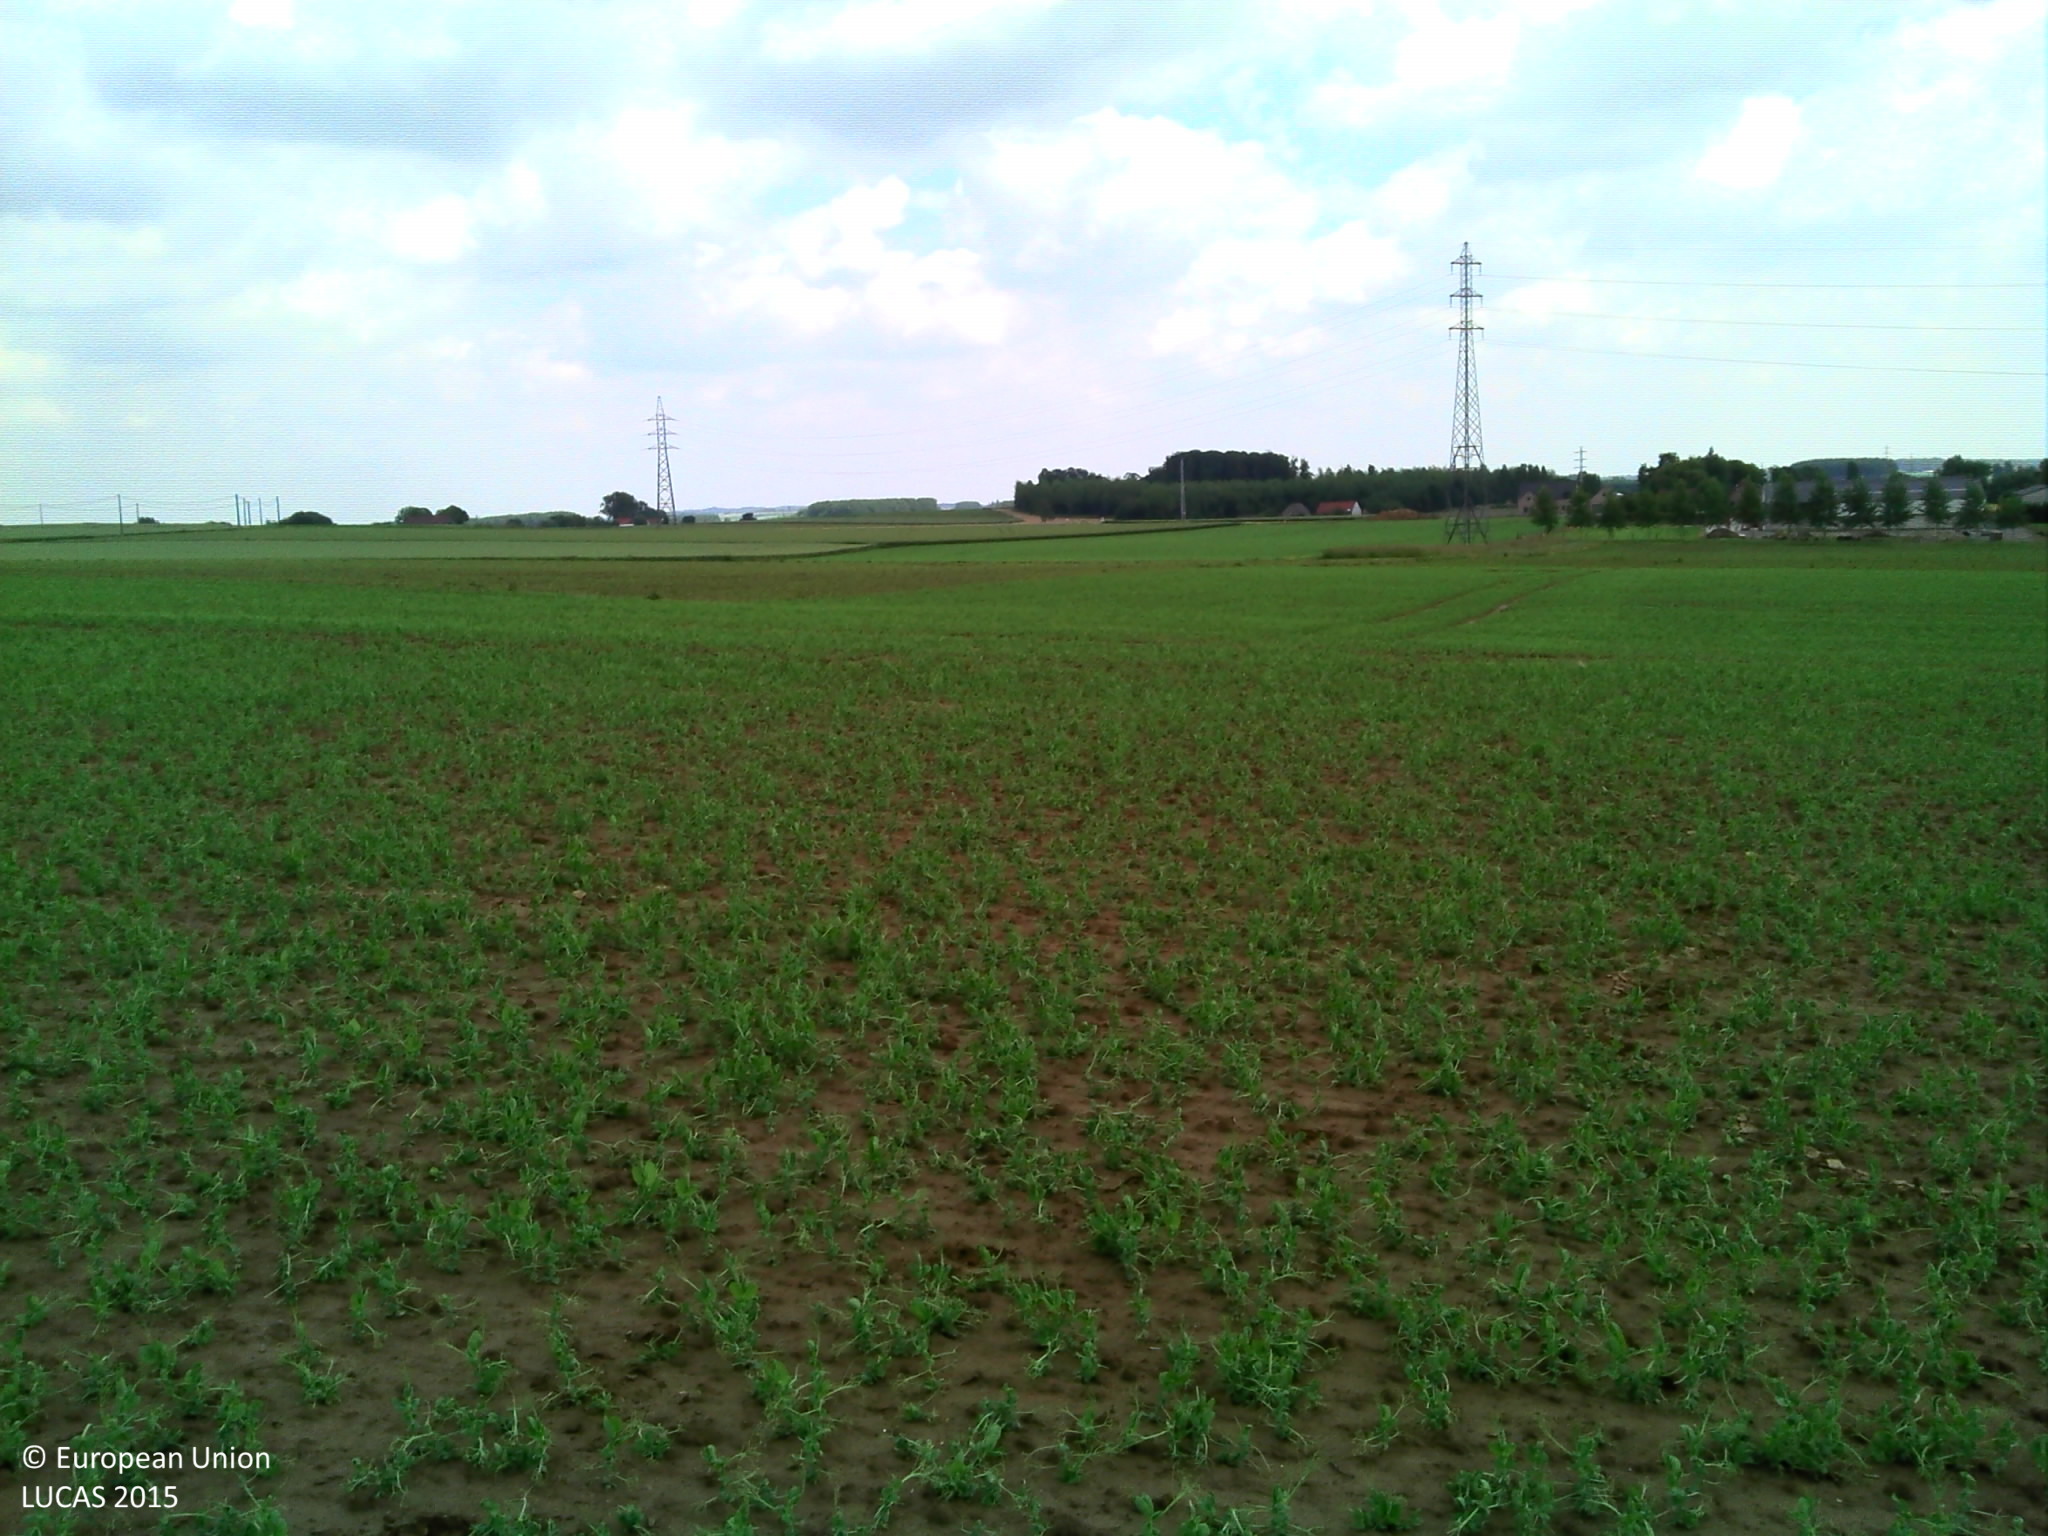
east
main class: Cropland
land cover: Dry pulses
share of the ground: 25 - 50 %
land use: Agriculture (excluding fallow land and kitchen gardens)
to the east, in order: Dry pulses; Other fresh vegetables; Dry pulses
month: June
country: BE
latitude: 50.6295
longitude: 3.8156
